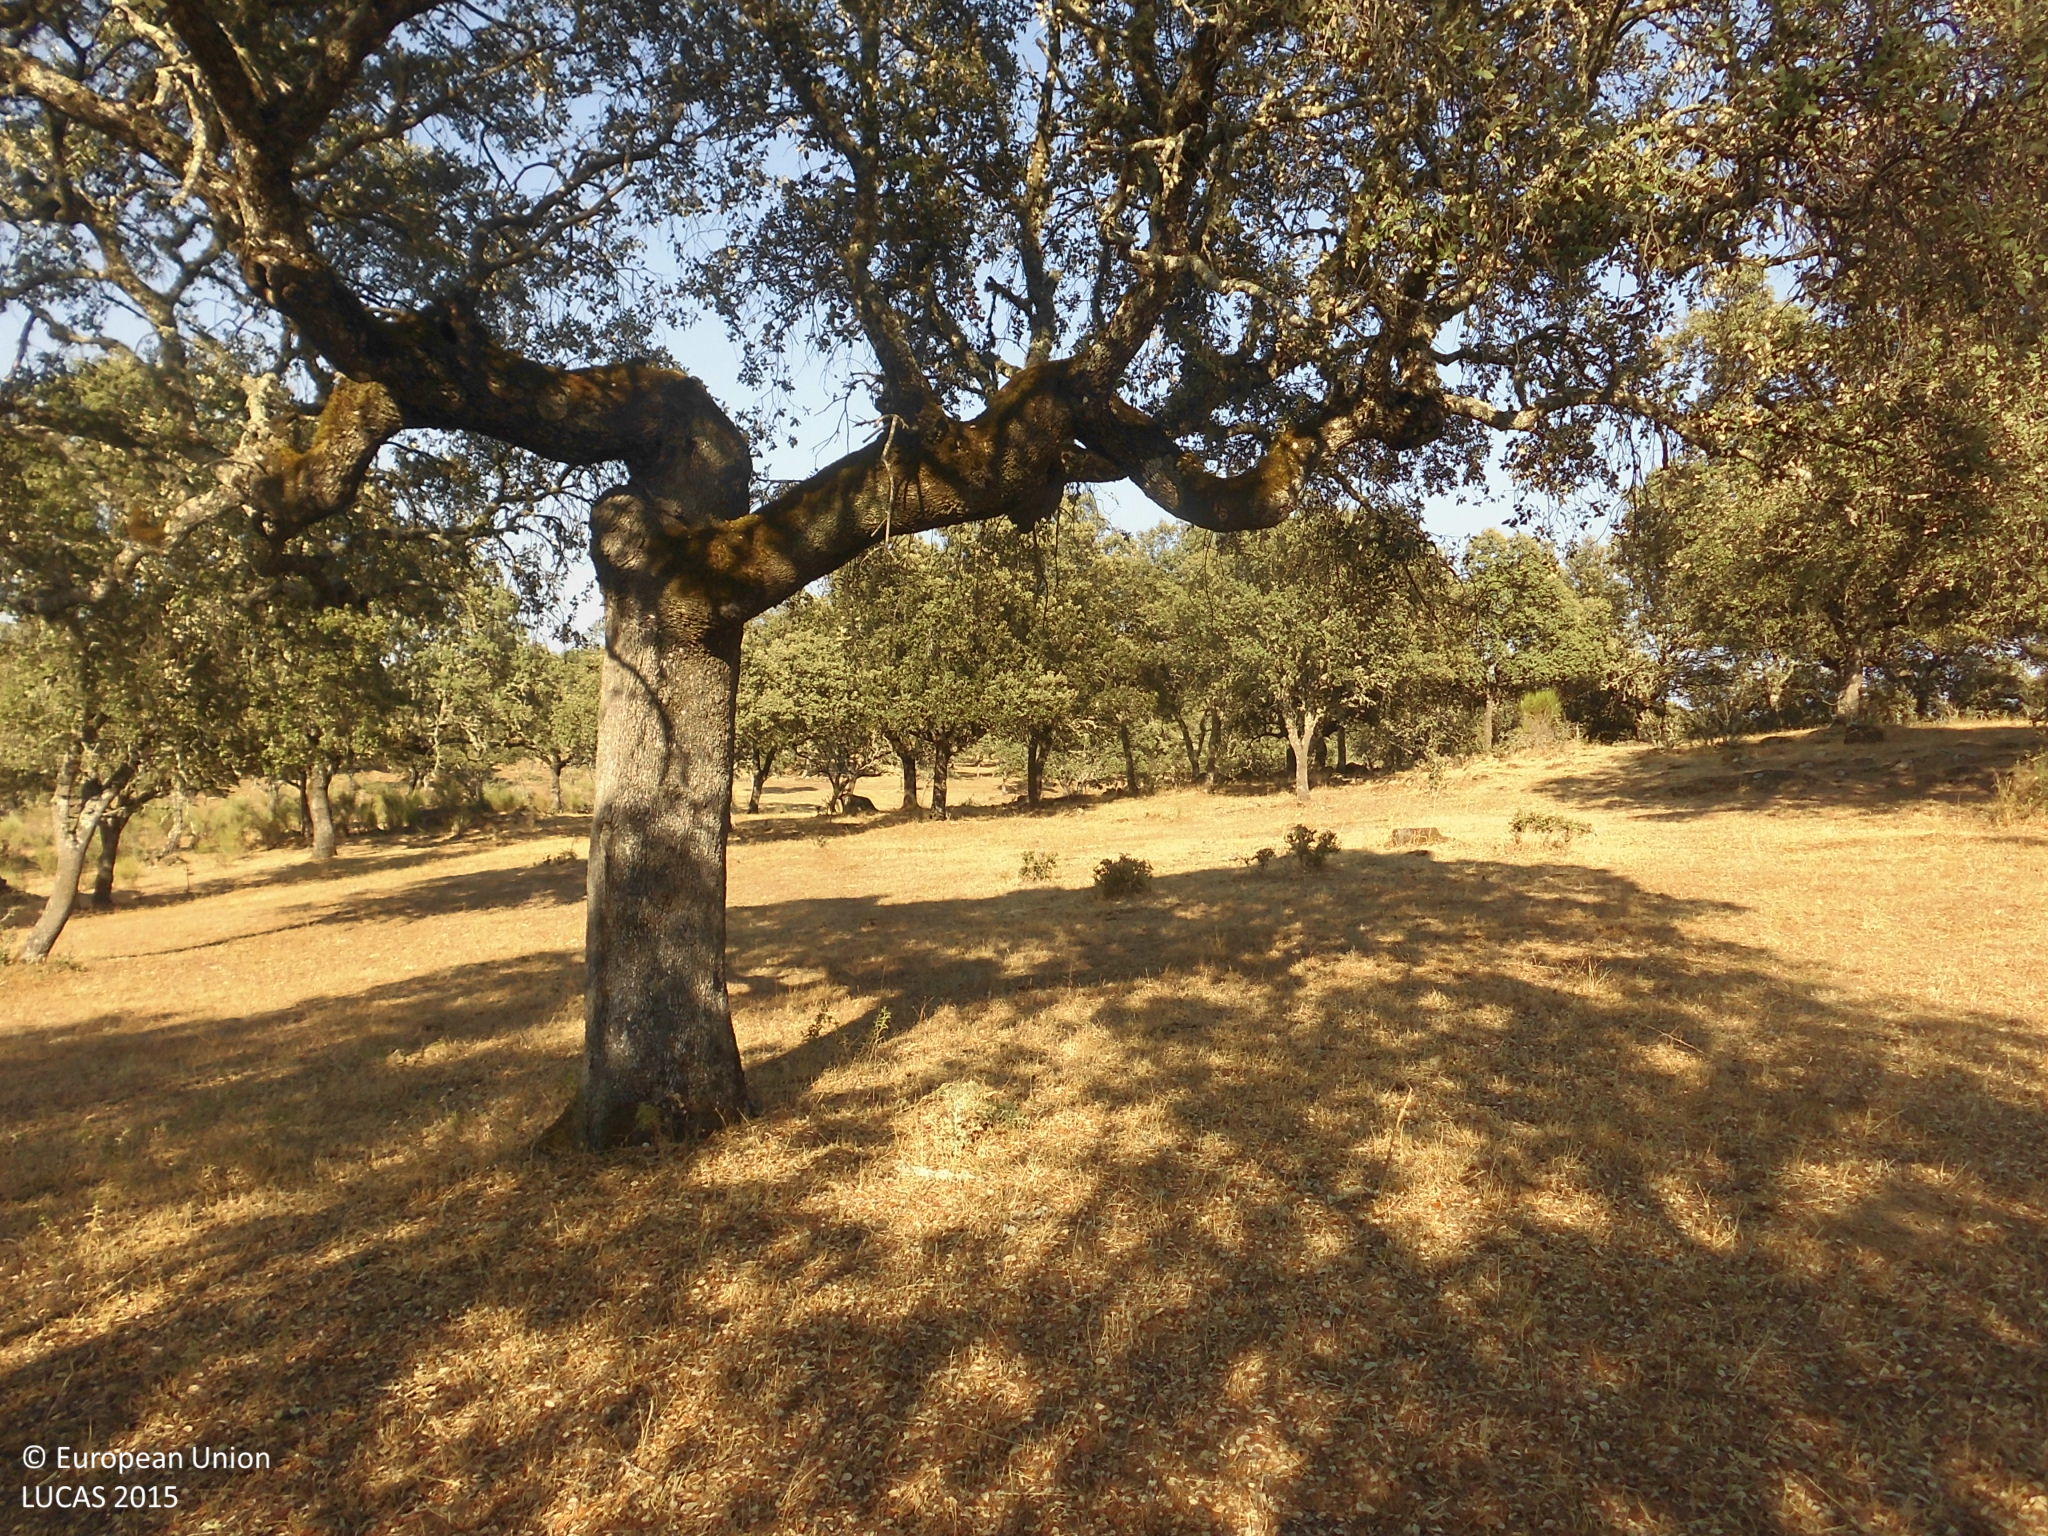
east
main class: Woodland
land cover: Broadleaved woodland
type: broadleaved evergreen forest
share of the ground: 25 - 50 %
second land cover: Grassland without tree/shrub cover
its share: > 75 %
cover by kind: herbaceous plants 70 %, broadleaved forest trees 30 %
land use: Forestry
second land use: Agriculture (excluding fallow land and kitchen gardens)
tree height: > 5 m
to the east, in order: Broadleaved woodland; Grassland without tree/shrub cover; Broadleaved woodland; Rivers and streams; Broadleaved woodland
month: July
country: ES
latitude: 40.1532
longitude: -6.1460
